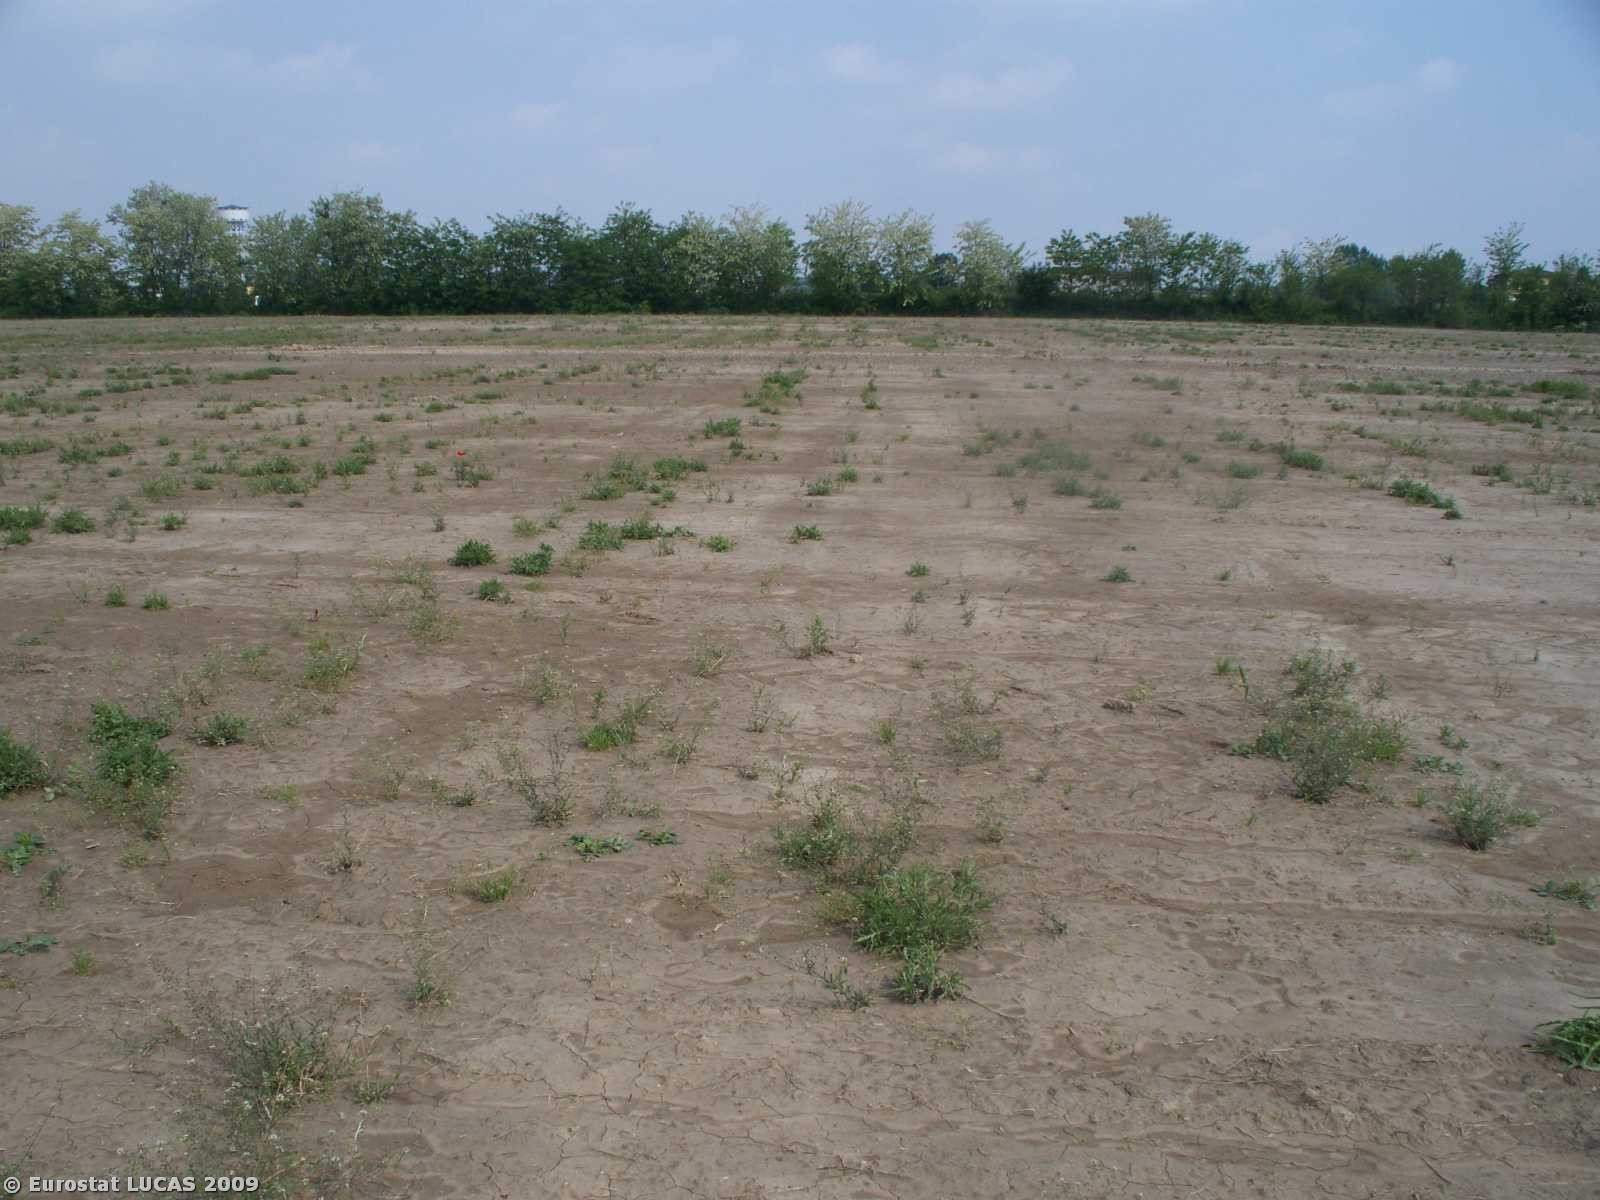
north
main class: Grassland
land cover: Spontaneously vegetated surfaces
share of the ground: > 75 %
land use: Fallow land
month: May
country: IT
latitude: 45.1236
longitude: 12.0686
